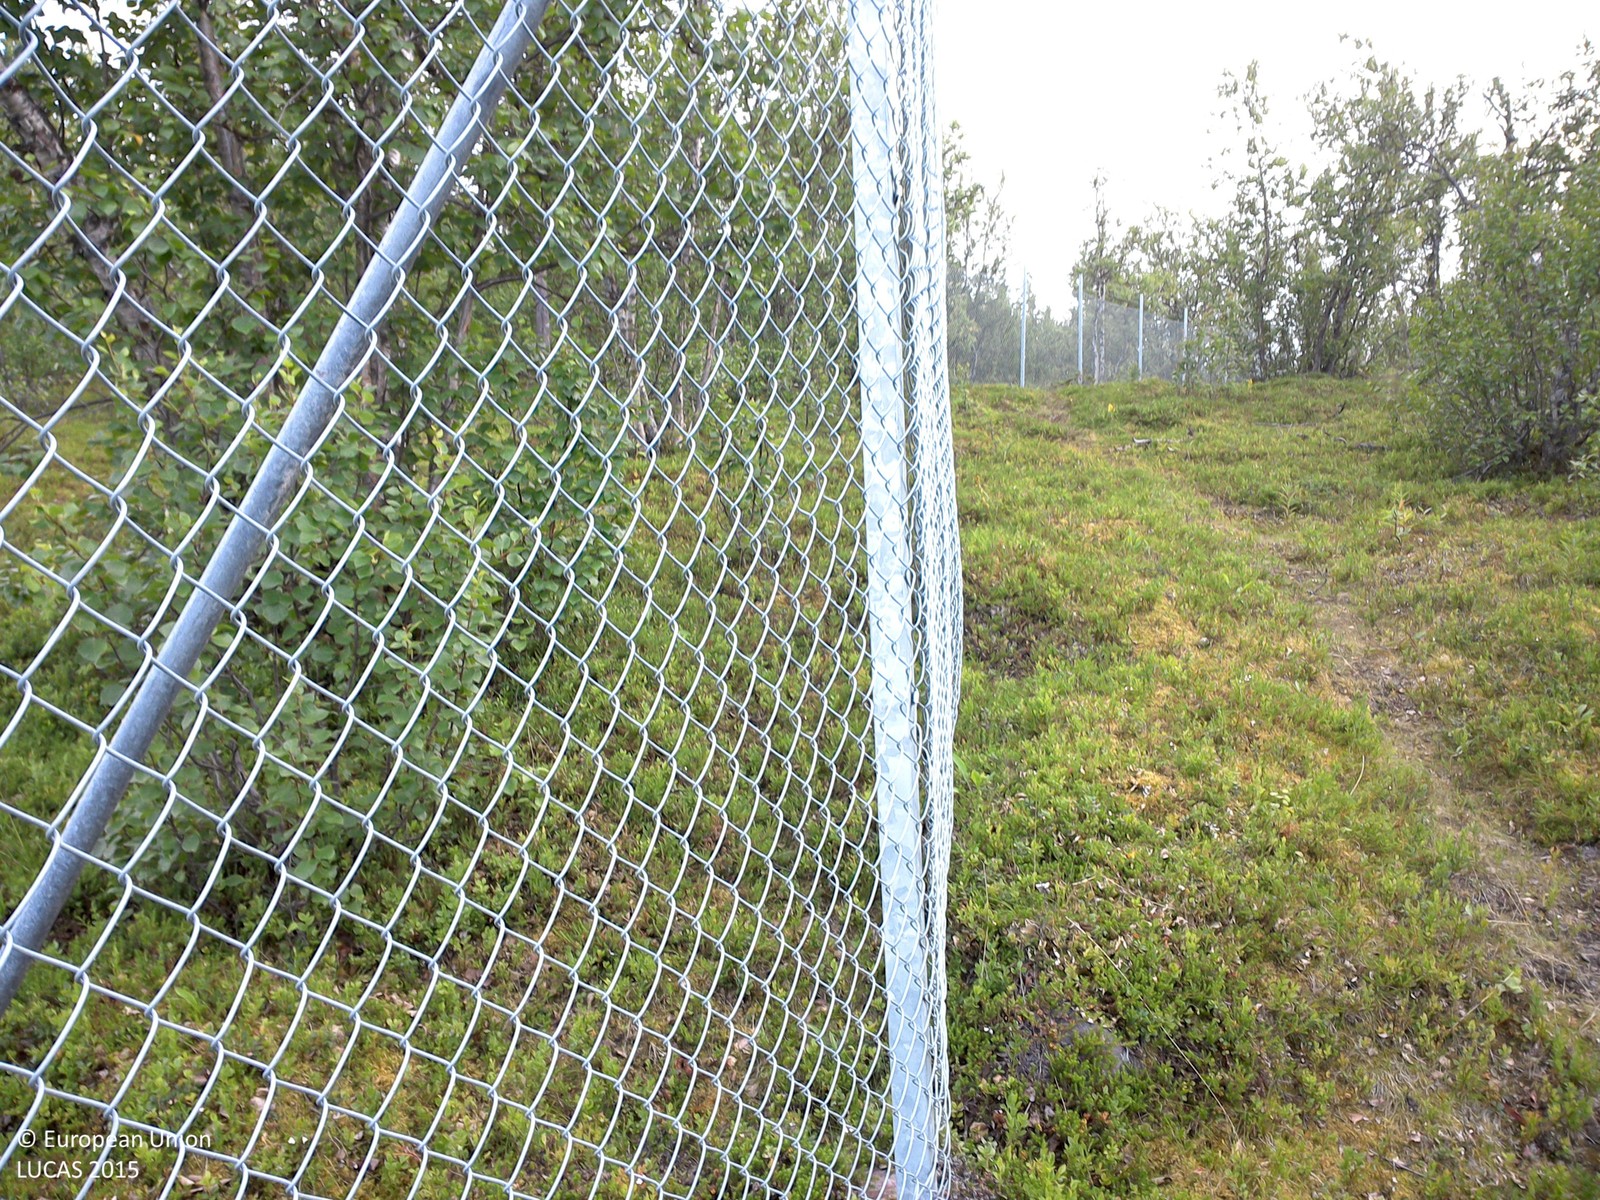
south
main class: Woodland
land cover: Broadleaved woodland
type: boreal forest
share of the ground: 10 - 25 %
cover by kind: shrubs 80 %, broadleaved forest trees 20 %
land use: Mining and quarrying
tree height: > 5 m
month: August
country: SE
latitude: 67.8728
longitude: 20.1446
